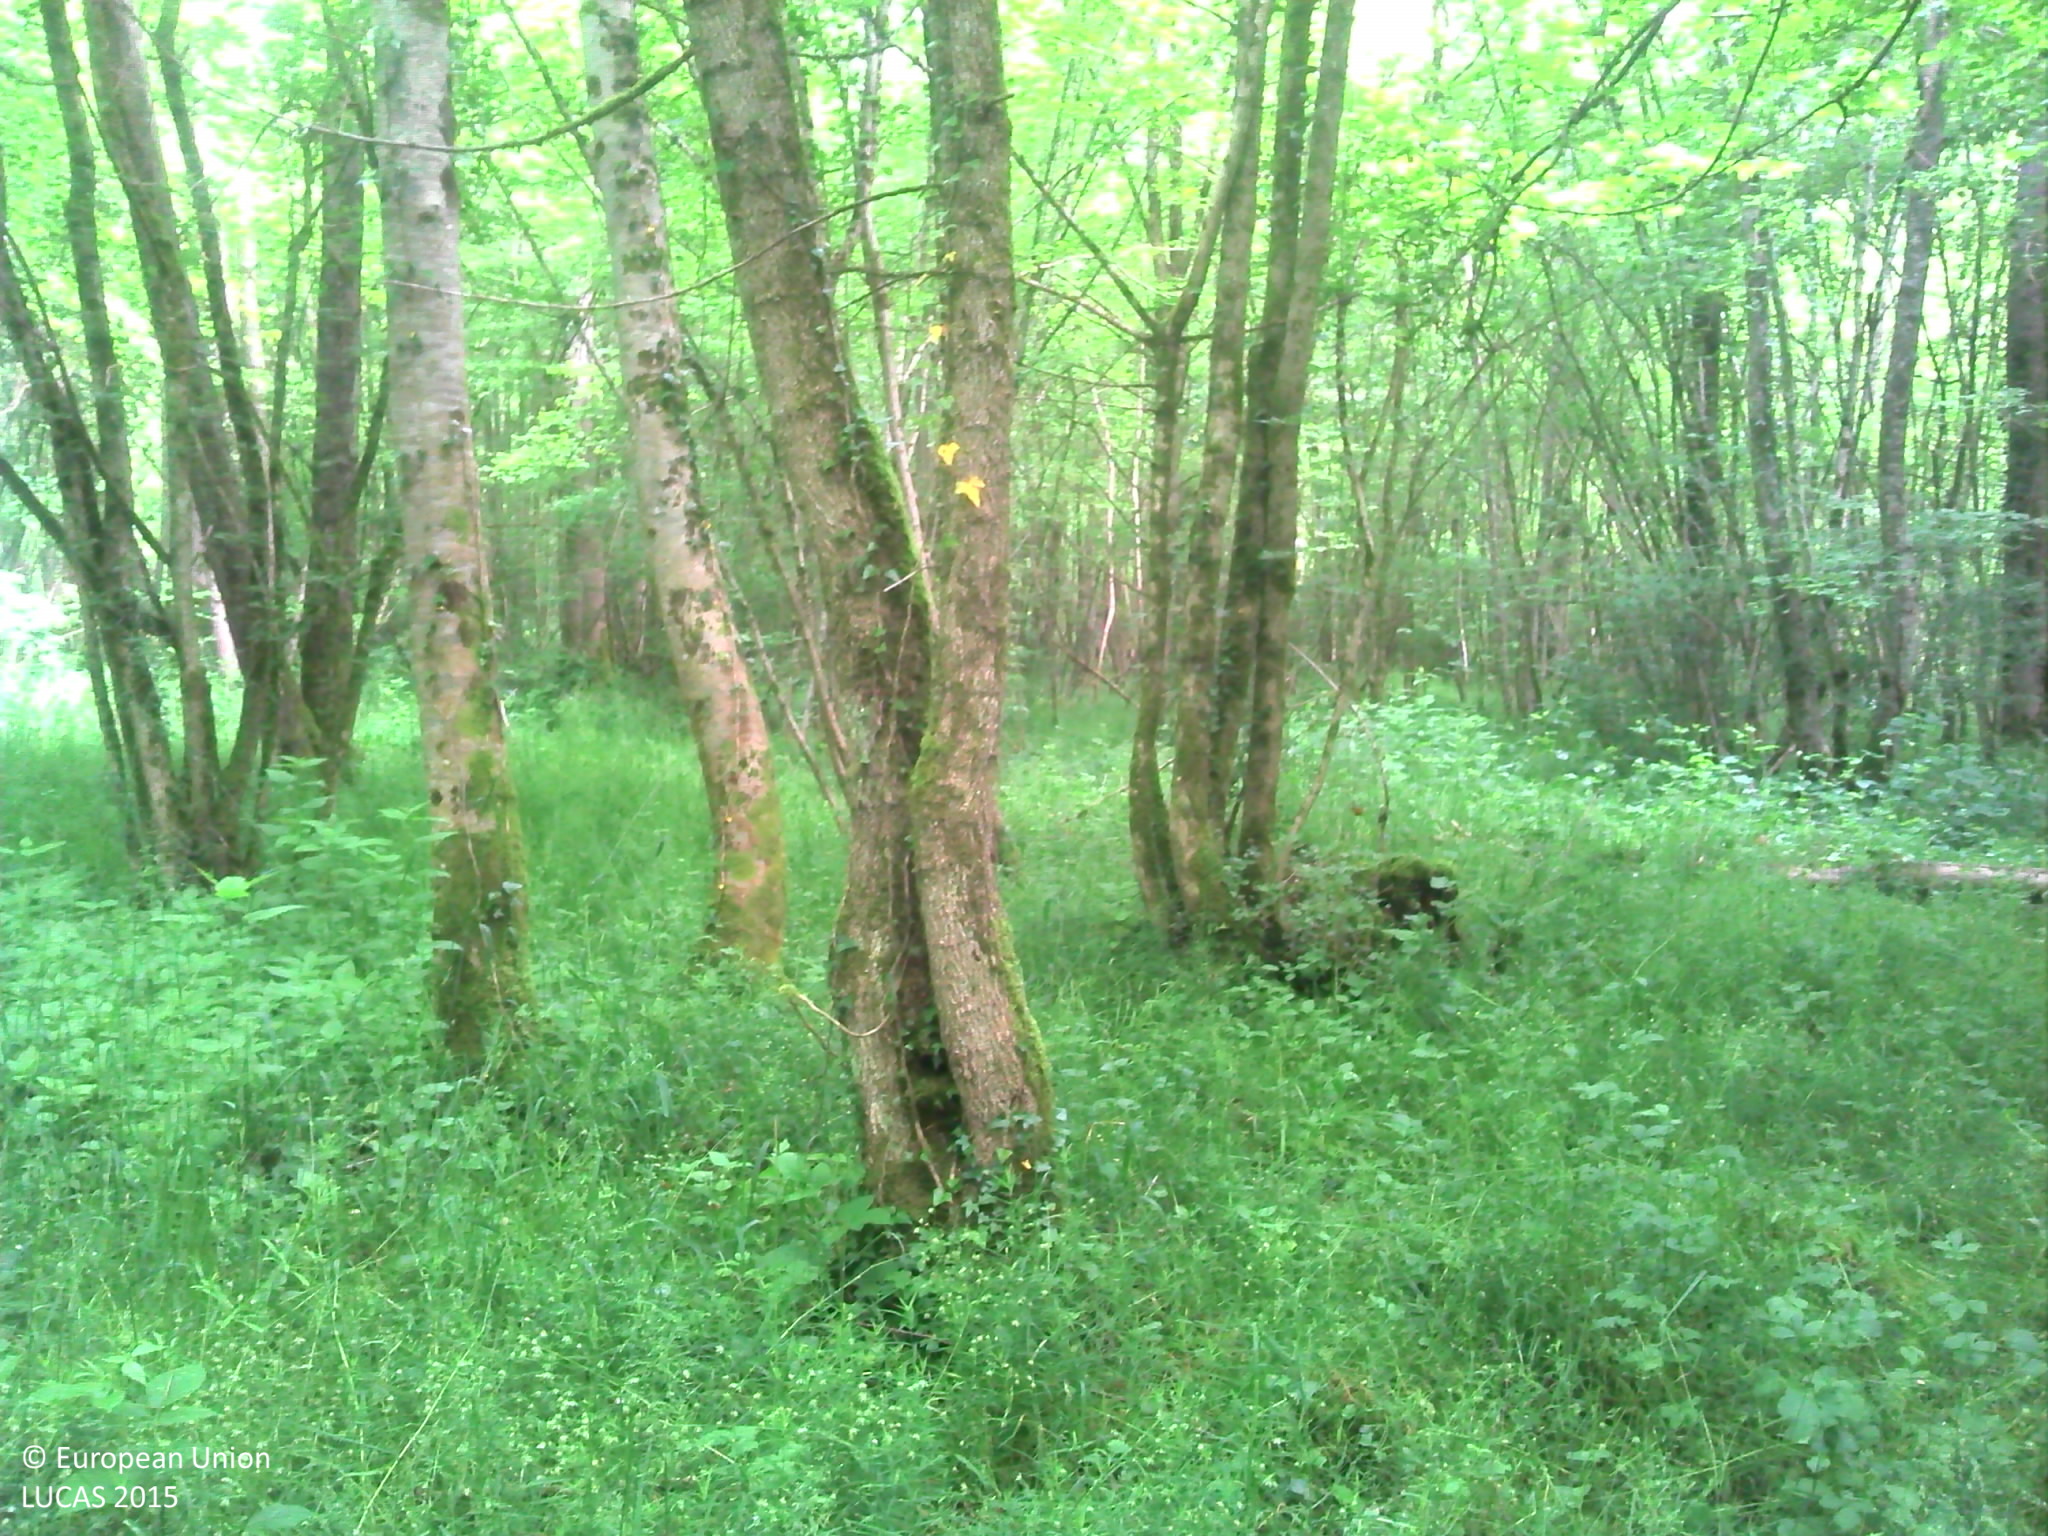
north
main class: Woodland
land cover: Broadleaved woodland
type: mesophytic deciduous forest
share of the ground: > 75 %
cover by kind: broadleaved forest trees 85 %, herbaceous plants 10 %, coniferous forest trees 5 %
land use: Forestry
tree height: > 5 m
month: May
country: FR
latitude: 48.6660
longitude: 4.9334
